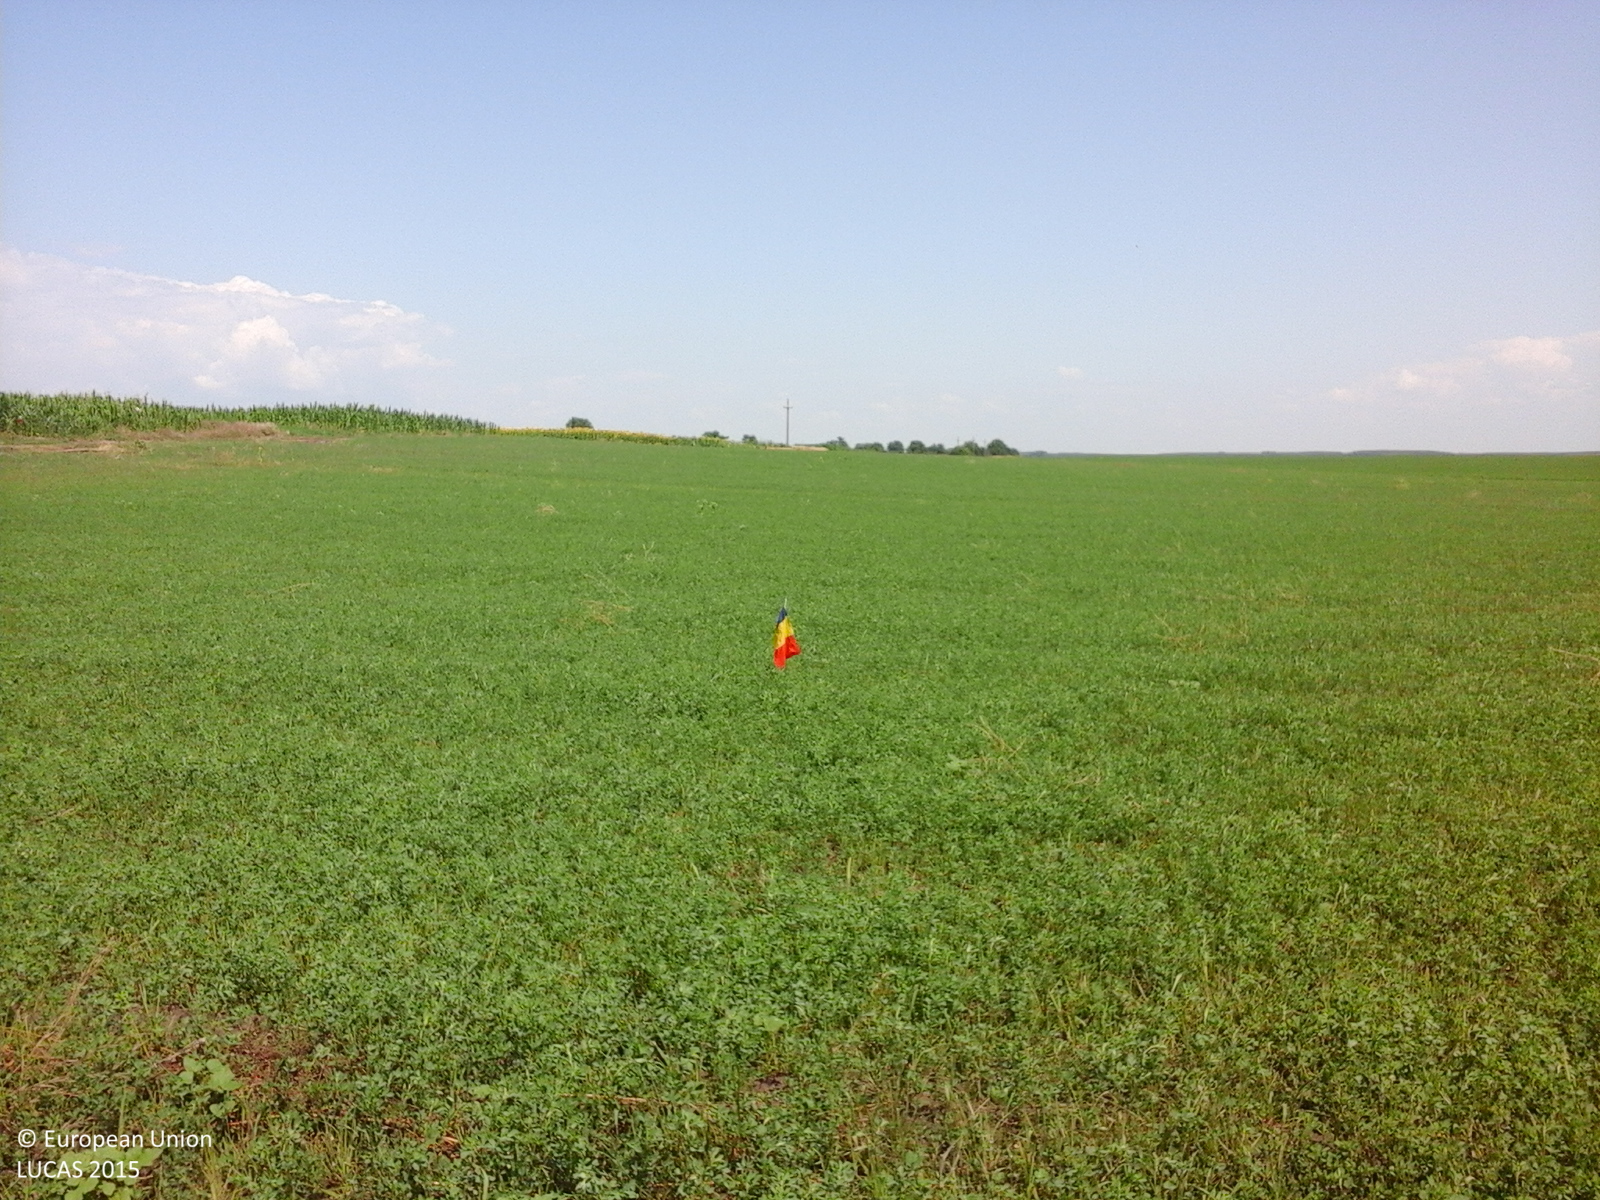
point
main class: Cropland
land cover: Lucerne
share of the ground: > 75 %
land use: Agriculture (excluding fallow land and kitchen gardens)
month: July
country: RO
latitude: 43.9427
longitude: 26.0077
